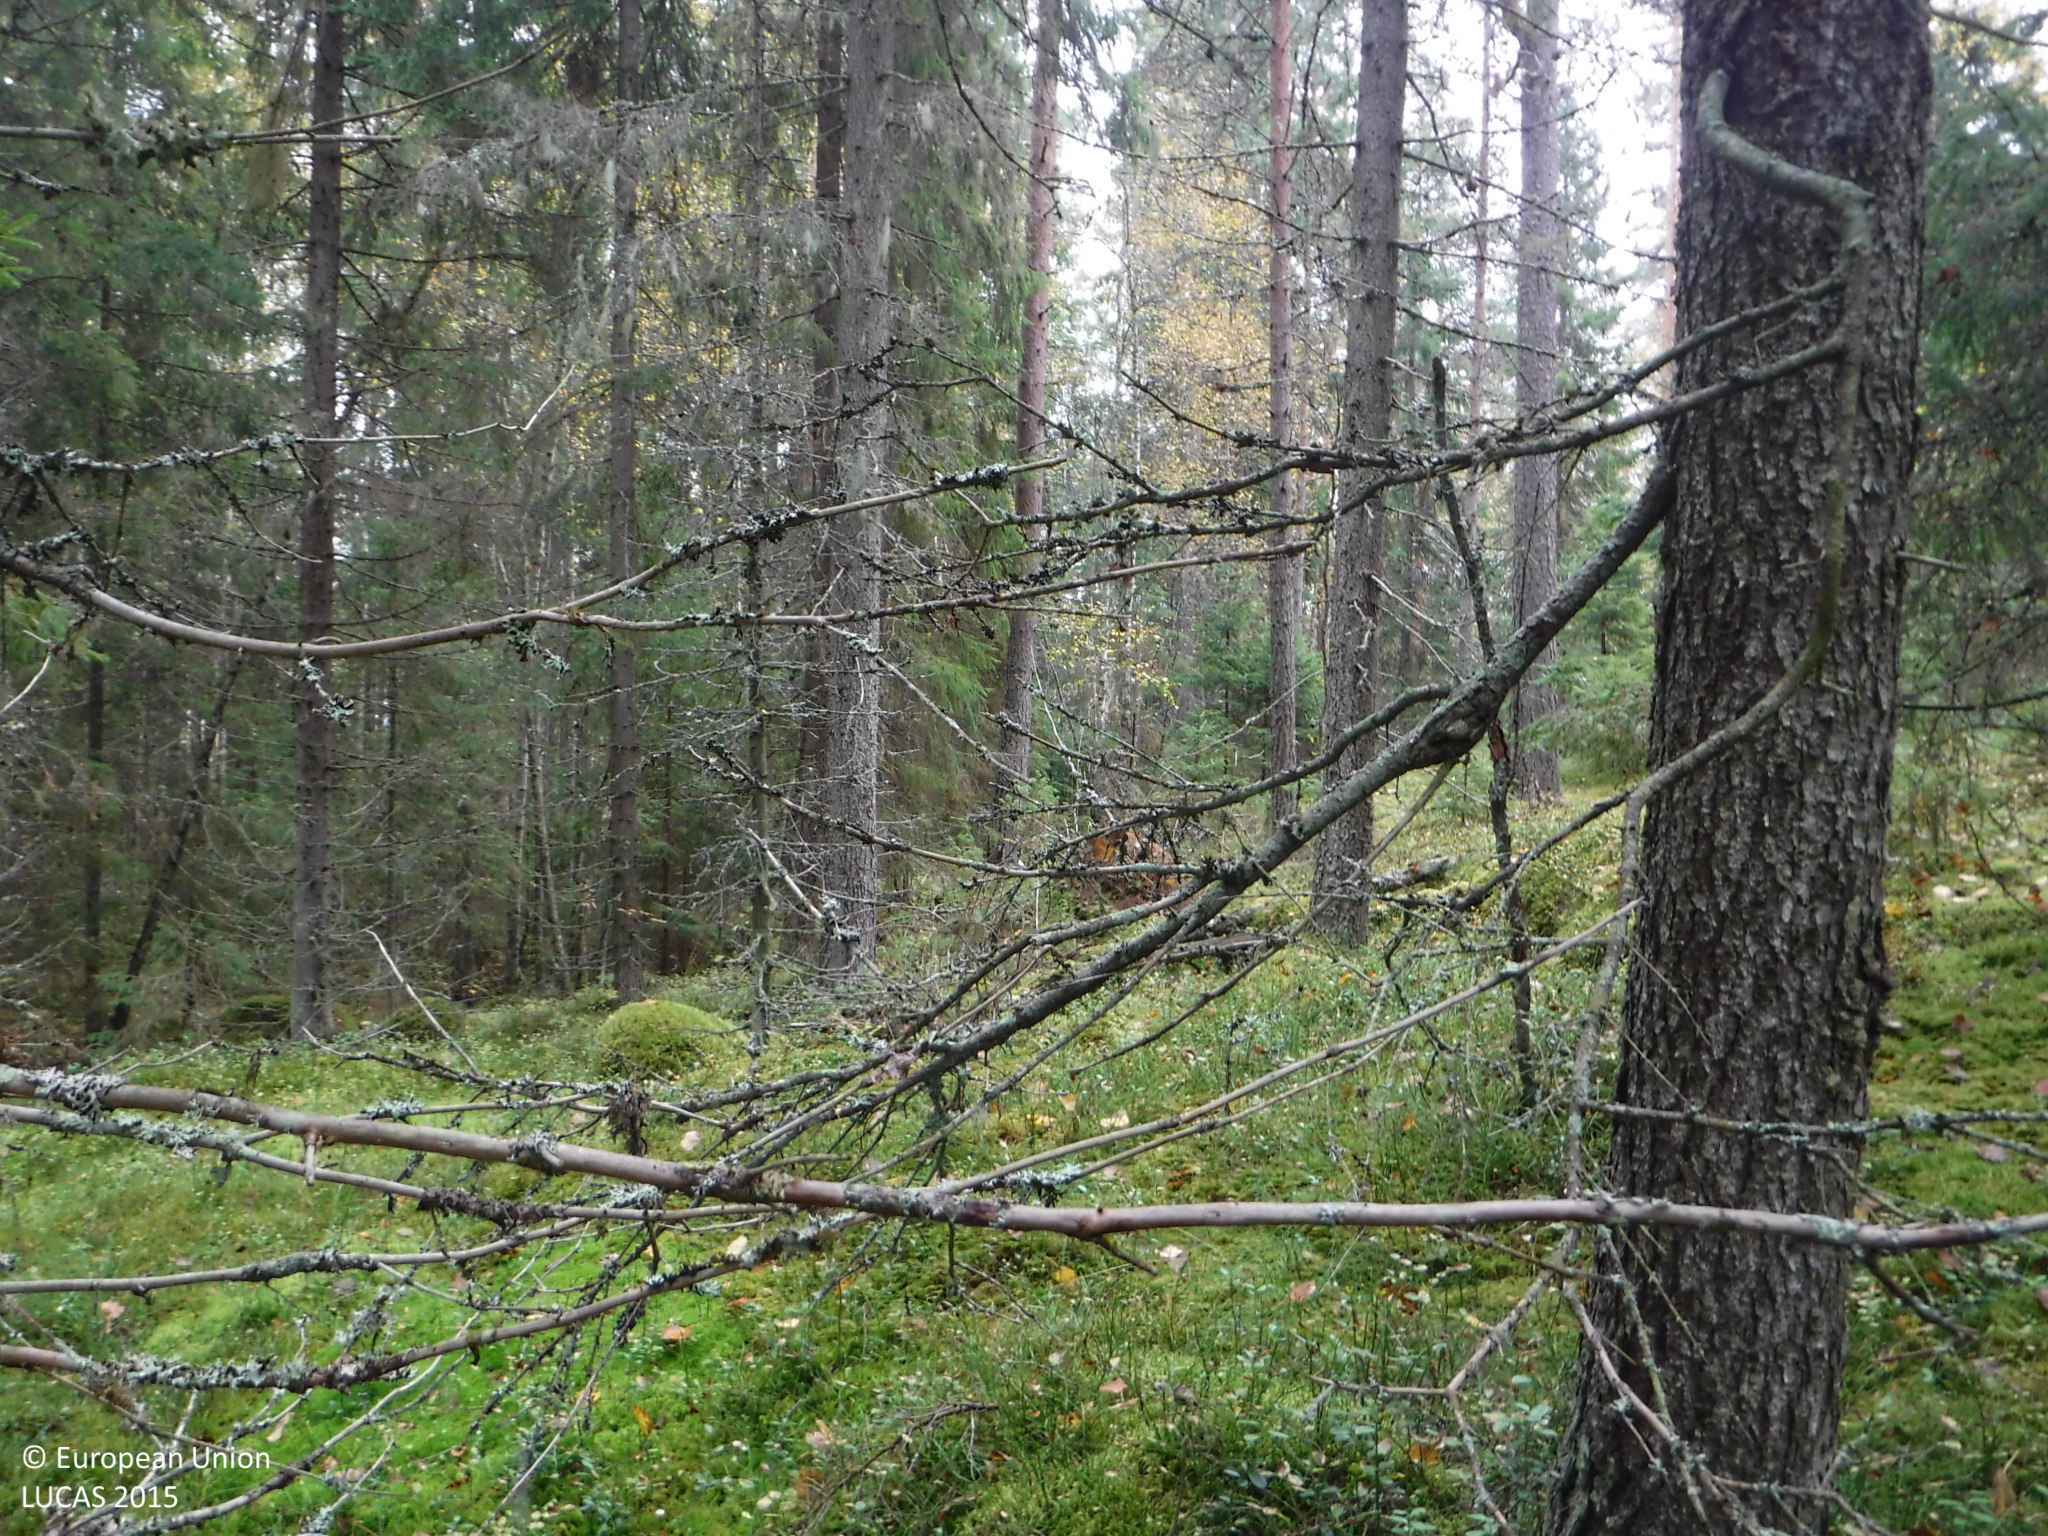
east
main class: Woodland
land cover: Spruce dominated coniferous woodland
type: boreal forest
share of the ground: 50 - 75 %
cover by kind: coniferous forest trees 60 %, lichens and mosses 30 %, shrubs 10 %
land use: Forestry
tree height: > 5 m
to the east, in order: Spruce dominated coniferous woodland; Spruce dominated mixed woodland; Pine dominated mixed woodland; Peatbogs; Pine dominated mixed woodland; Peatbogs; Inland fresh water bodies
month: September
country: FI
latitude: 61.5963
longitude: 23.8992
